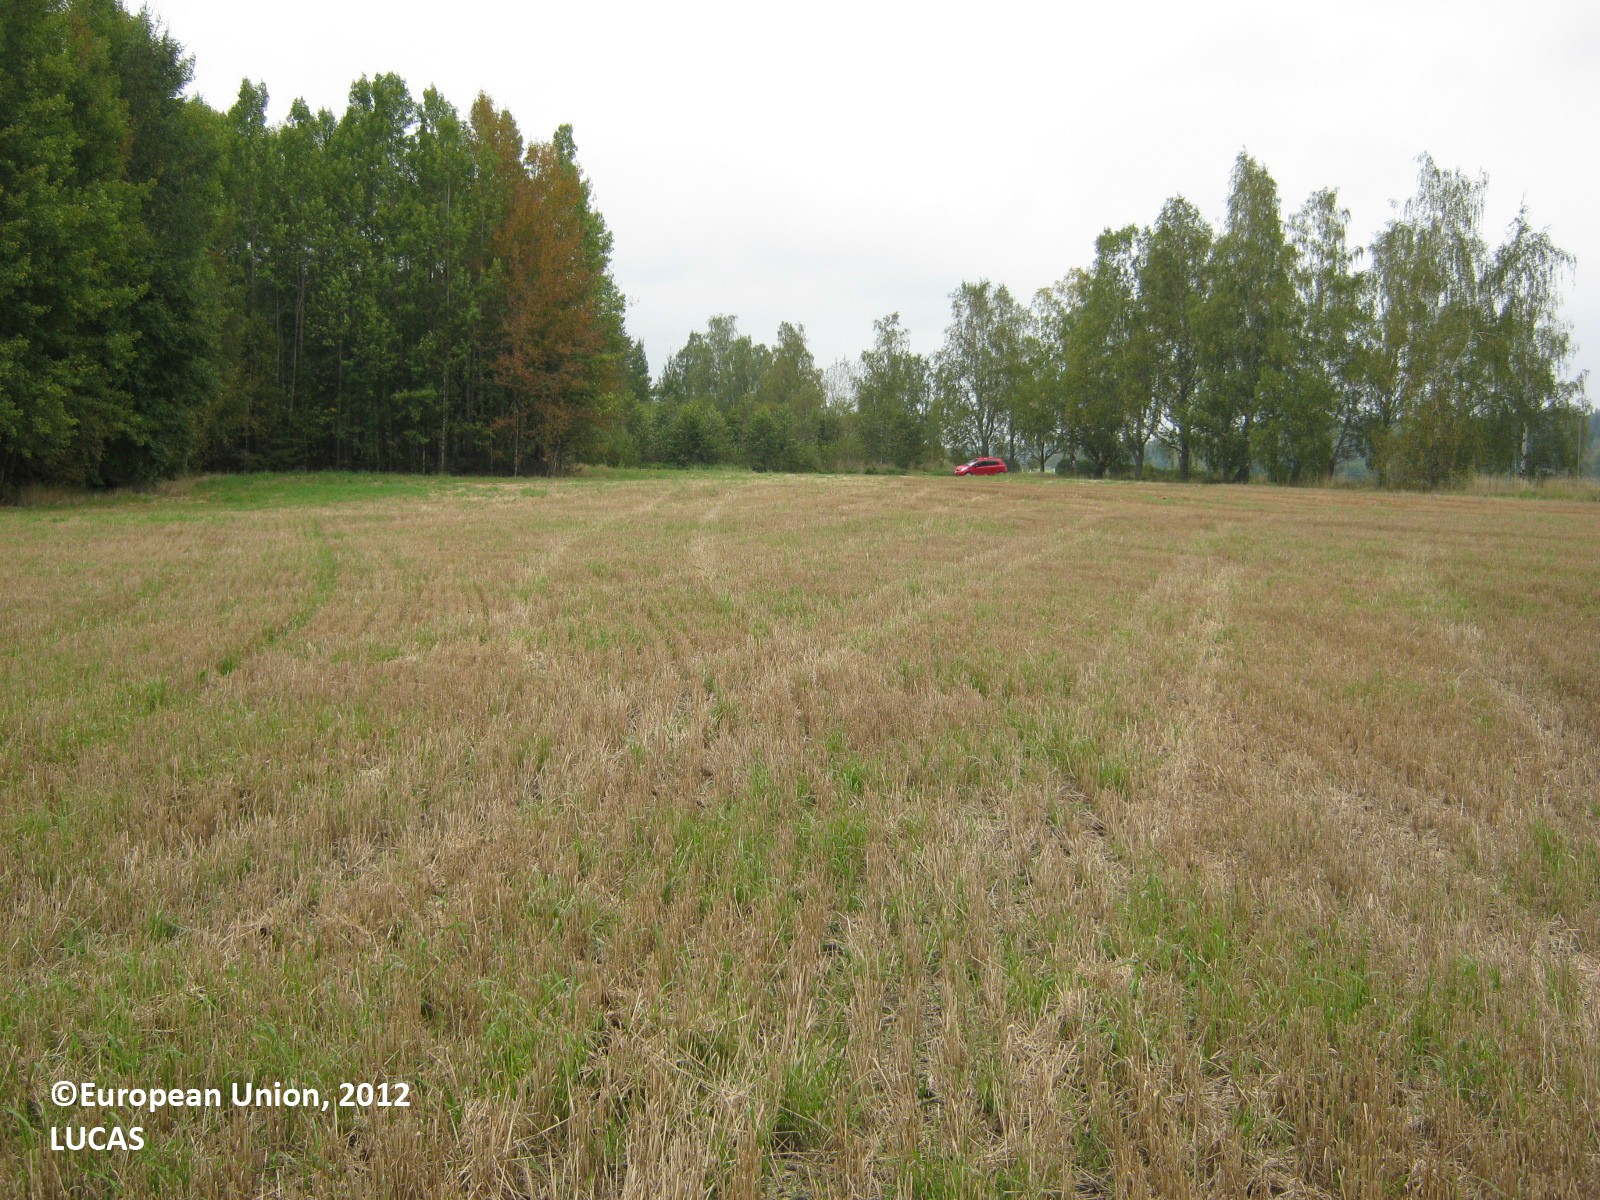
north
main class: Cropland
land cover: Barley
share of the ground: 50 - 75 %
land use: Agriculture (excluding fallow land and kitchen gardens)
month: September
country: FI
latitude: 60.5289
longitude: 27.5534
